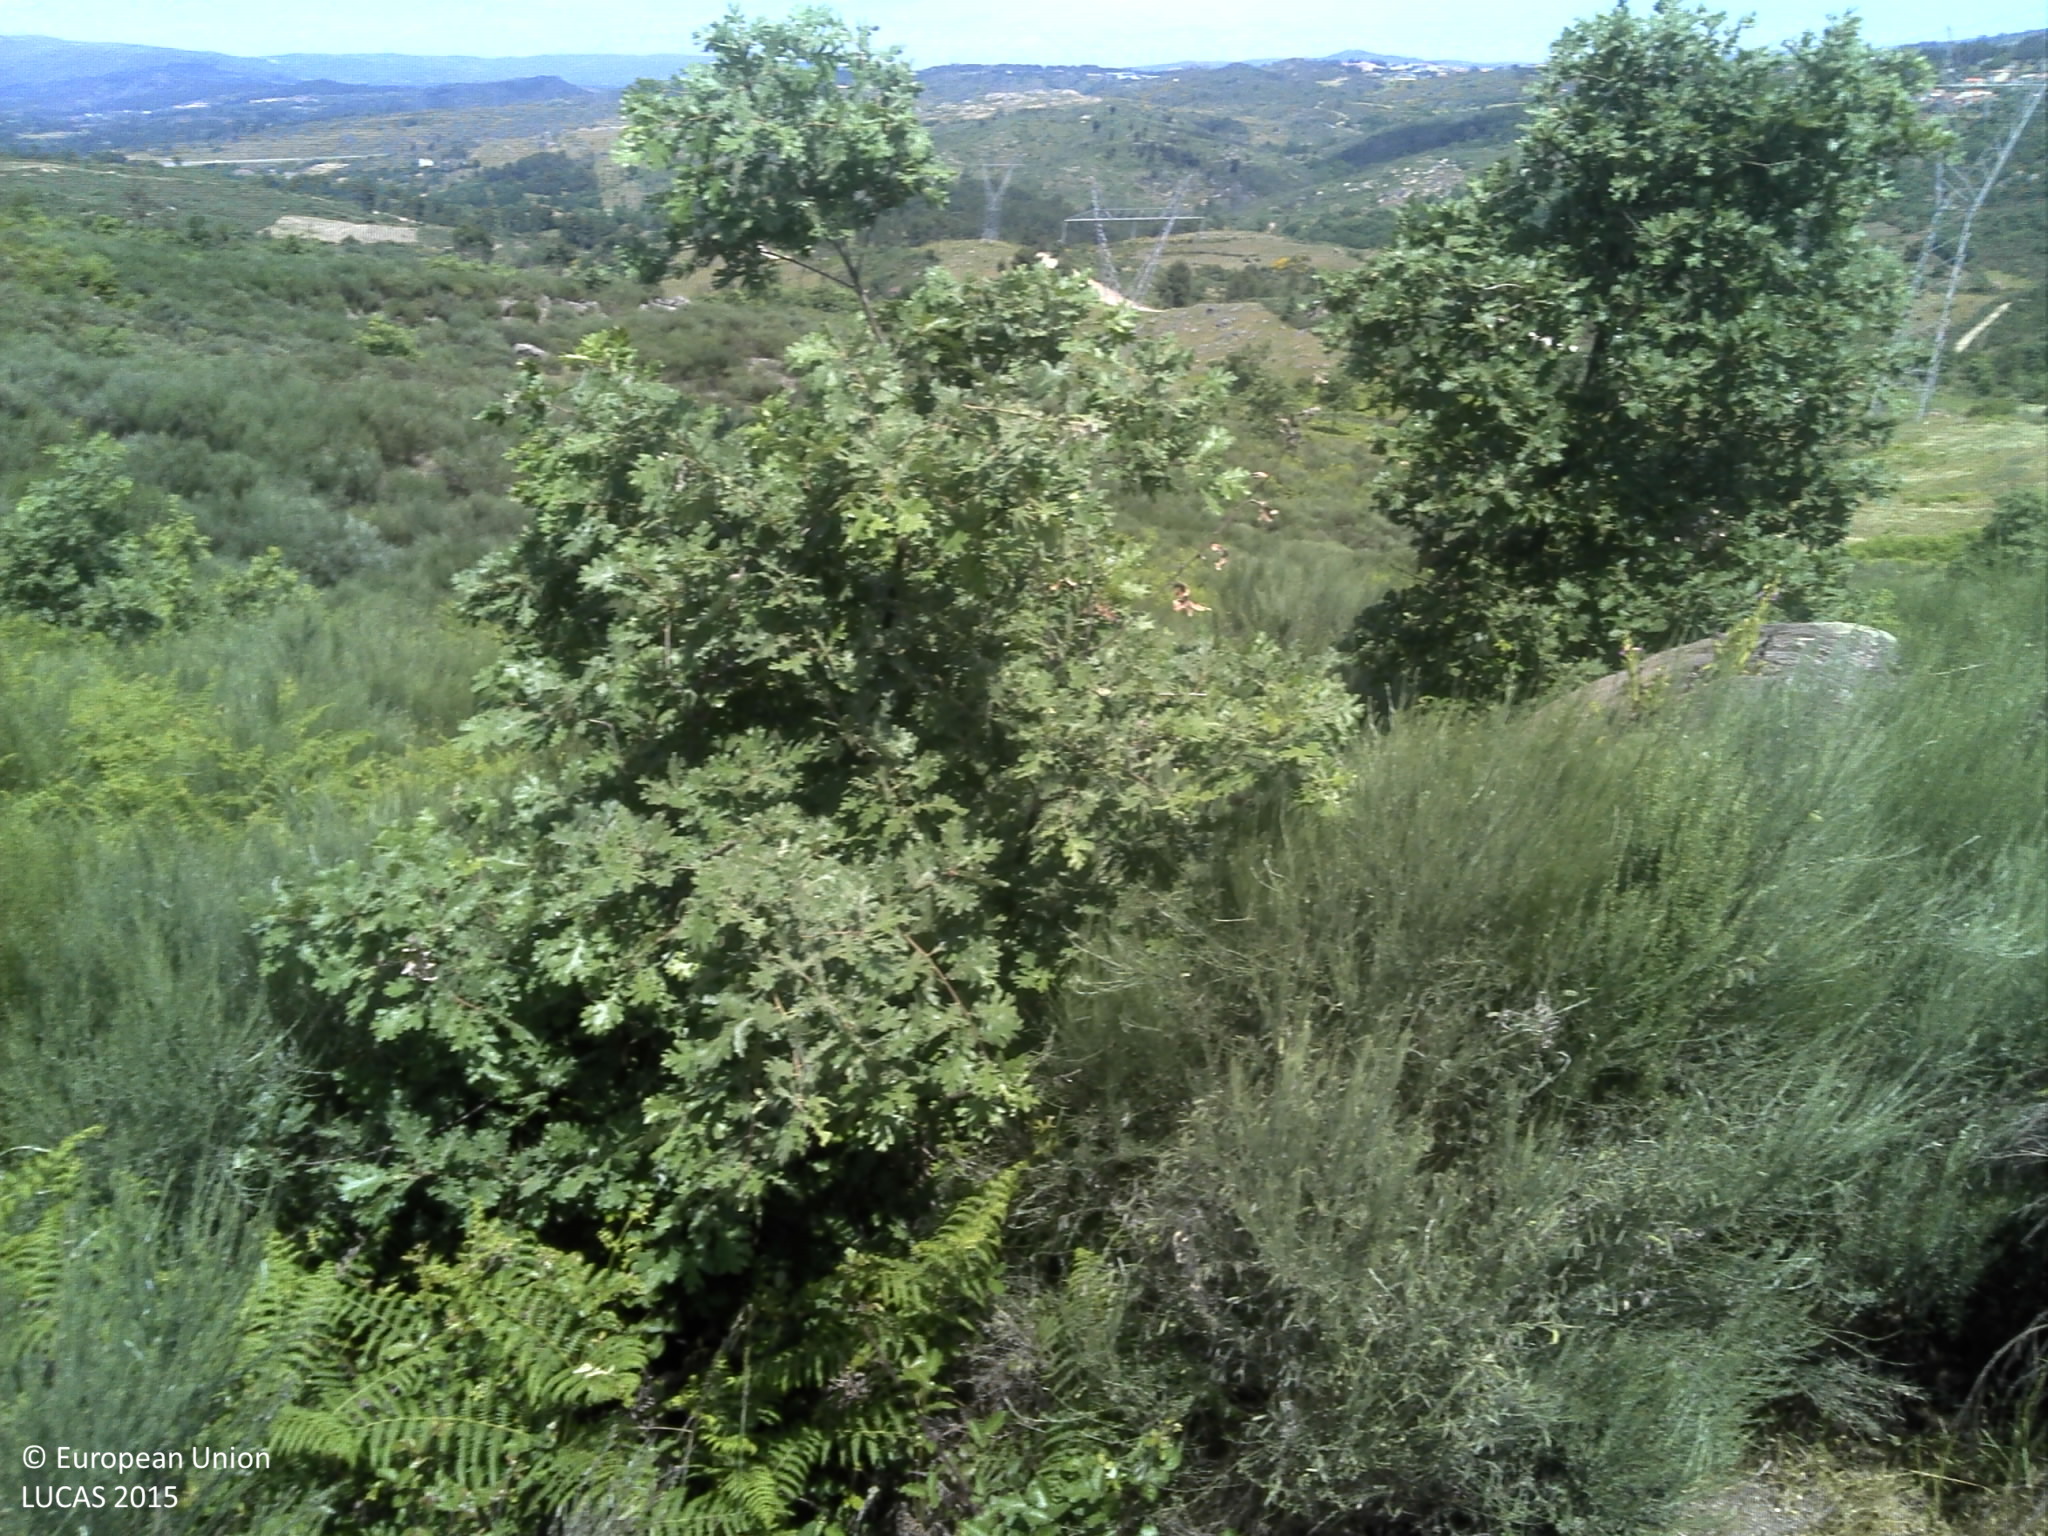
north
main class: Shrubland
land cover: Shrubland without tree cover
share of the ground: 50 - 75 %
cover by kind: shrubs 75 %, herbaceous plants 20 %, unconsolidated bare surface 5 %
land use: Semi-natural and natural areas not in use
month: May
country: PT
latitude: 40.6090
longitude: -7.4499
